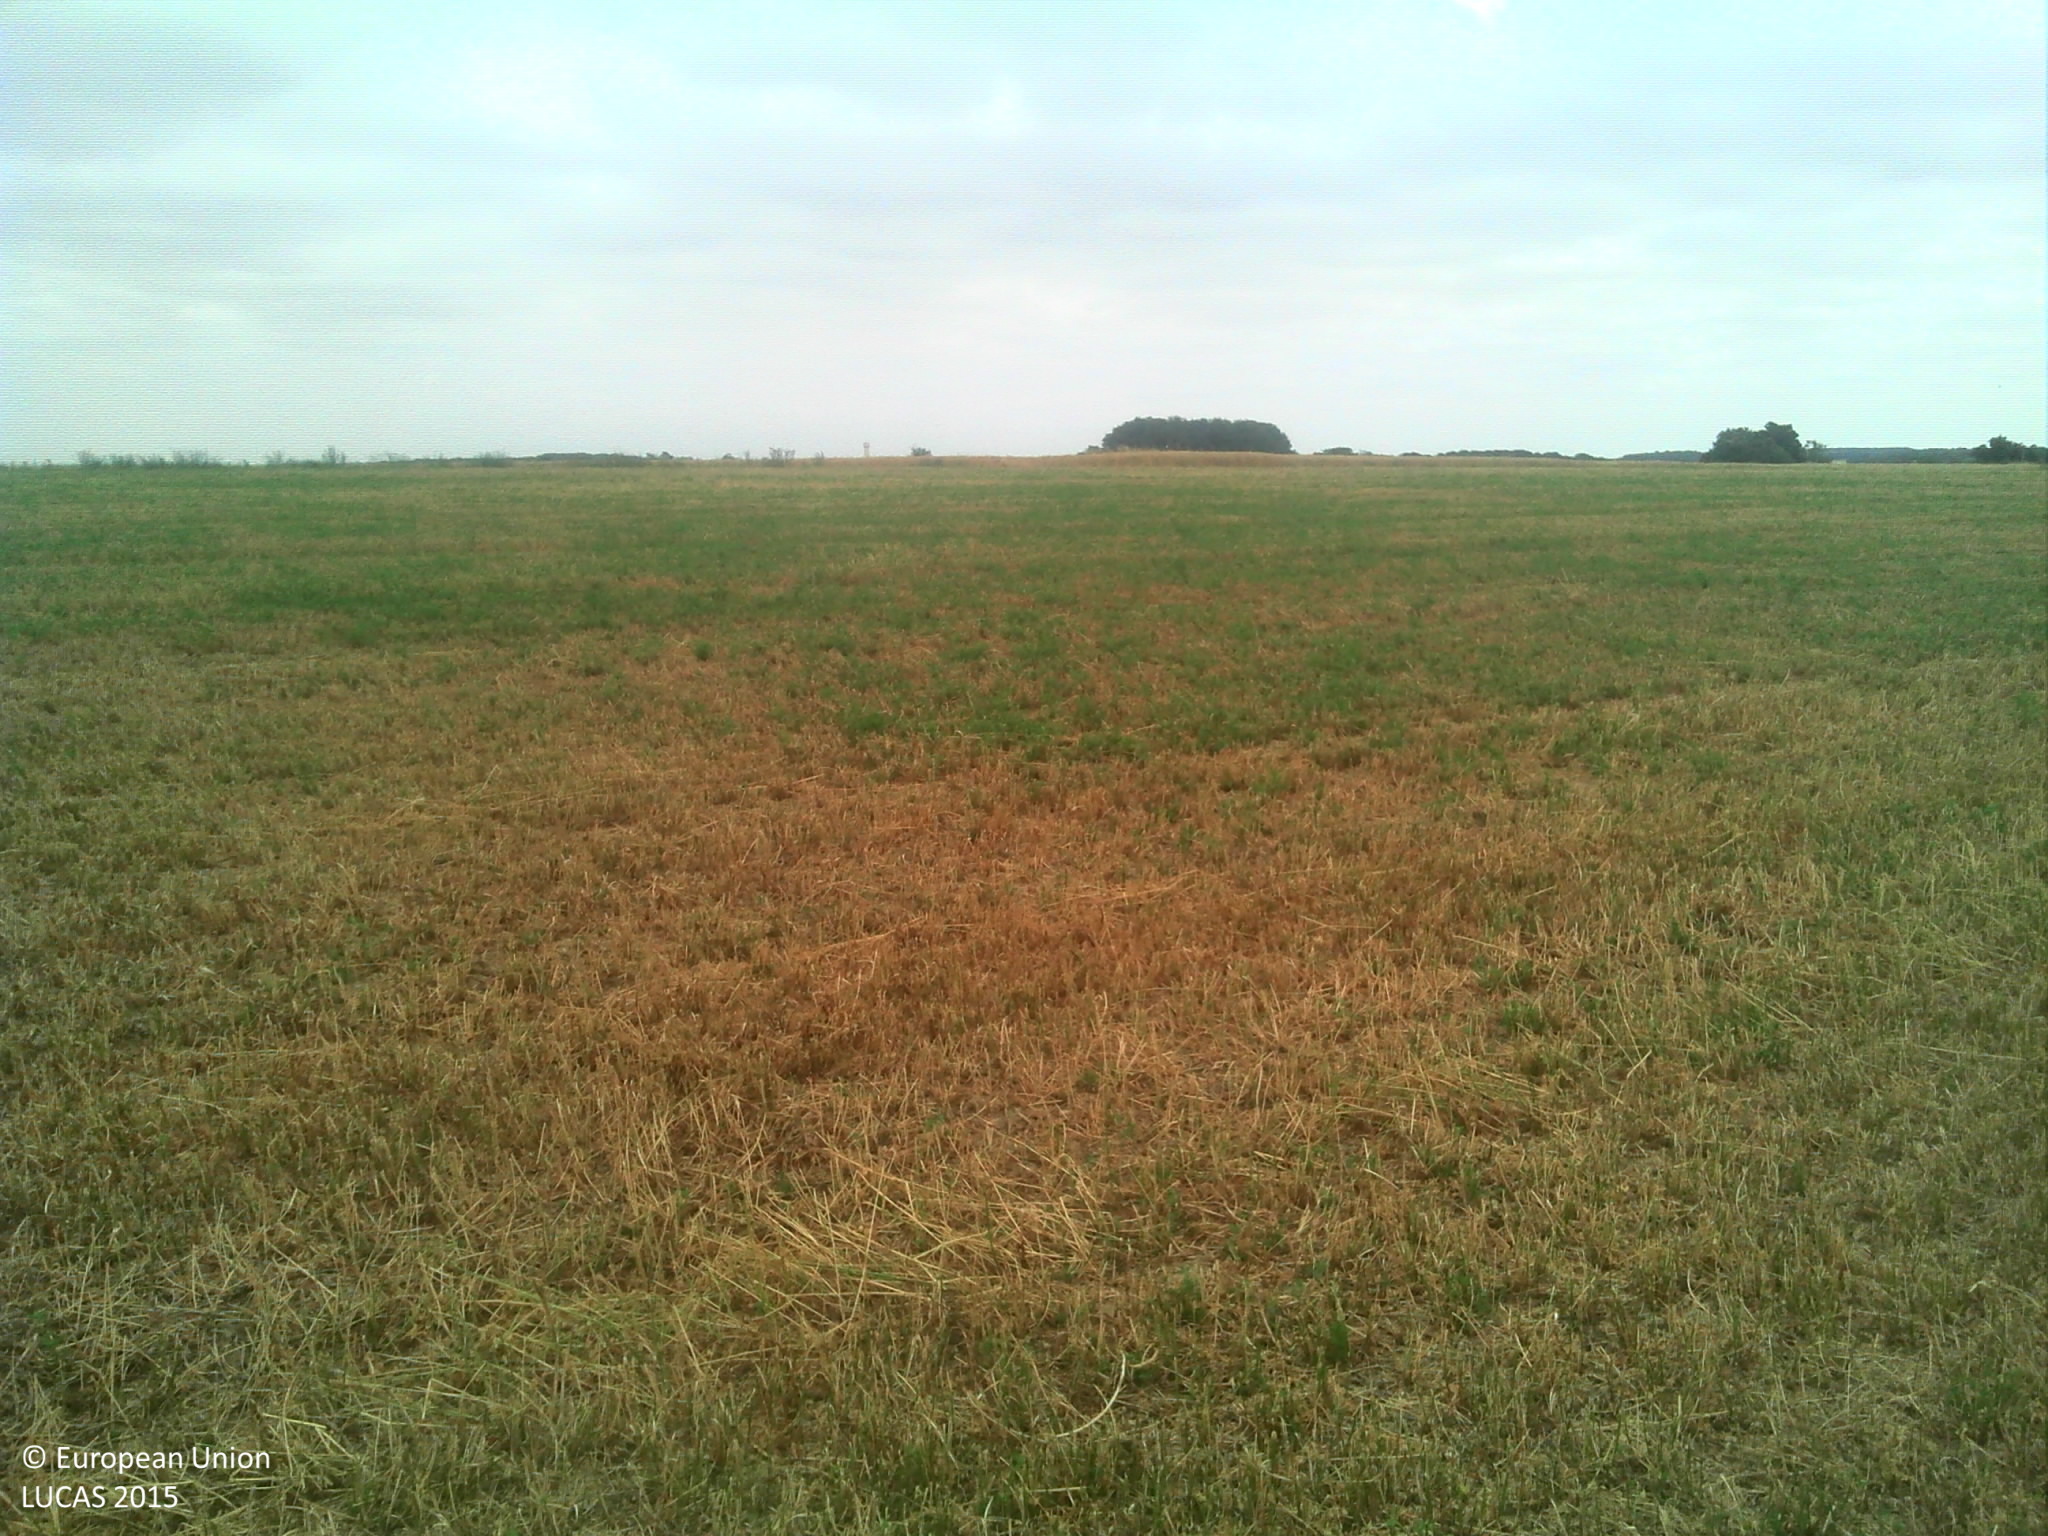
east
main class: Cropland
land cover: Common wheat
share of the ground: > 75 %
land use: Agriculture (excluding fallow land and kitchen gardens)
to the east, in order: Common wheat; Lucerne; Grass margins; Tracks; Grass margins; Barley
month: July
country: FR
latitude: 47.7244
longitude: 0.7407
